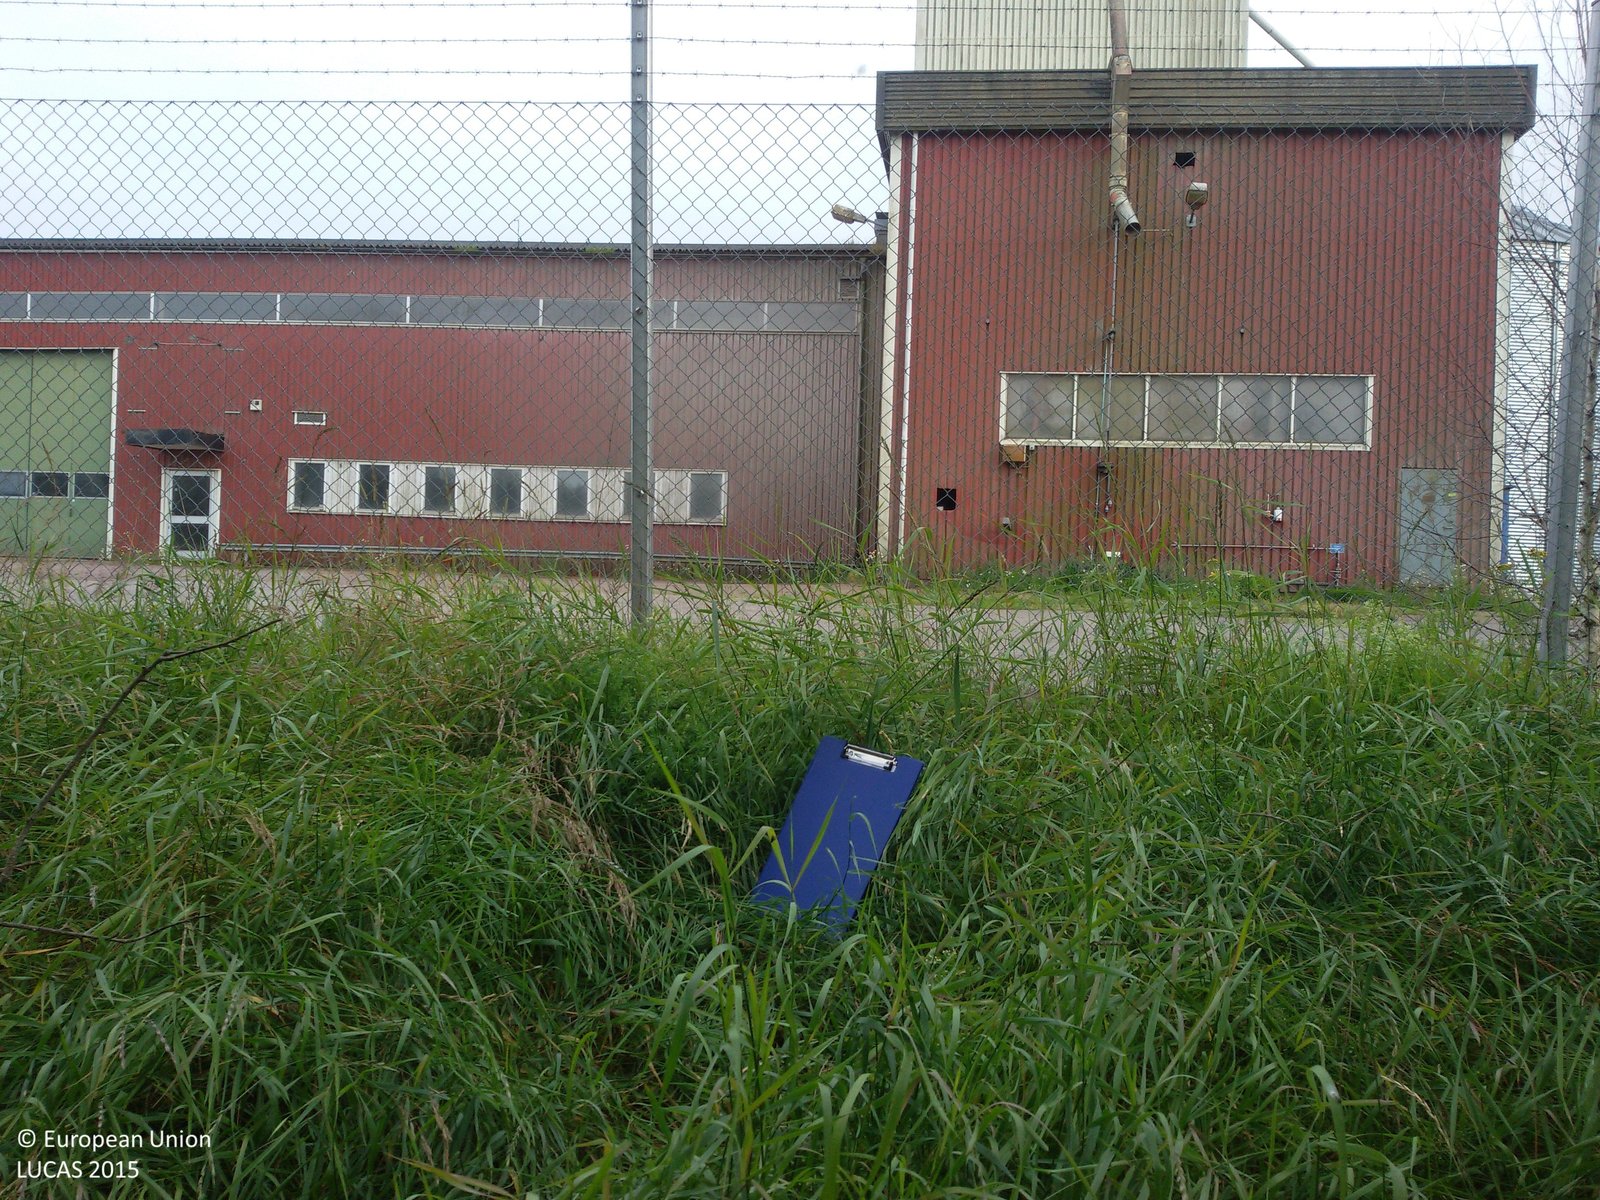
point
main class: Grassland
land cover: Spontaneously vegetated surfaces
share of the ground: > 75 %
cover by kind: herbaceous plants 100 %
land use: Semi-natural and natural areas not in use
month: July
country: SE
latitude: 60.4039
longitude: 15.8149
